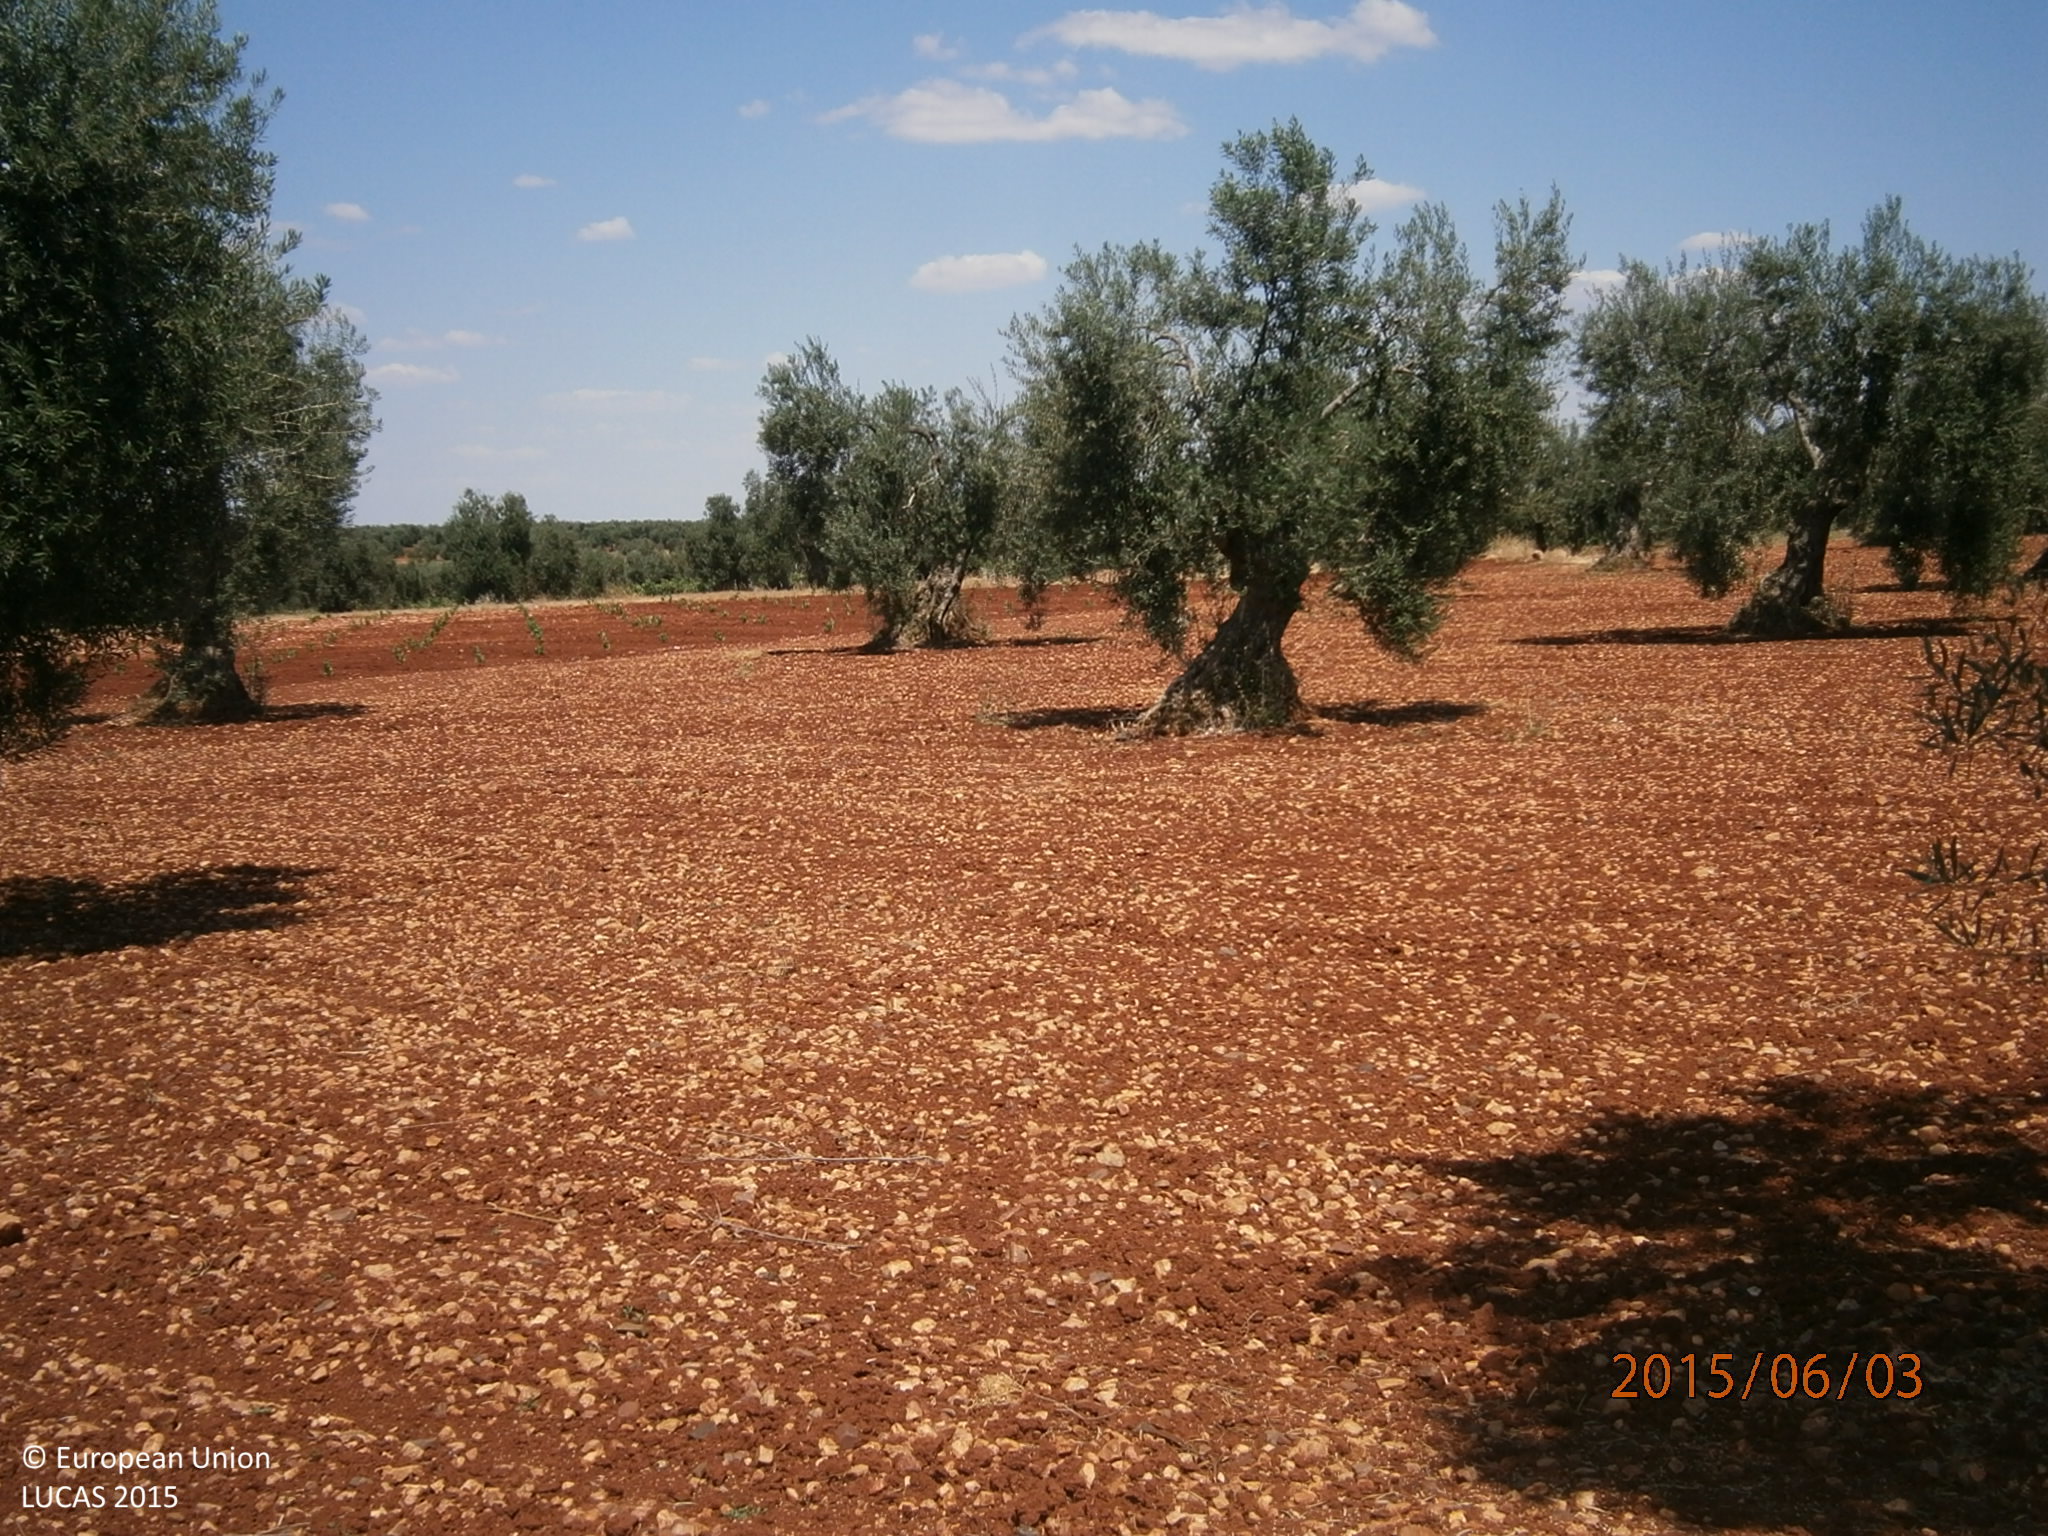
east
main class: Cropland
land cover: Olive groves
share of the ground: 10 - 25 %
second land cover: Other bare soil
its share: > 75 %
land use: Agriculture (excluding fallow land and kitchen gardens)
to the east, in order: Olive groves; Other bare soil; Grass margins; Olive groves; Vineyards; Olive groves
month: June
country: ES
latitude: 38.6330
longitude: -6.4240
